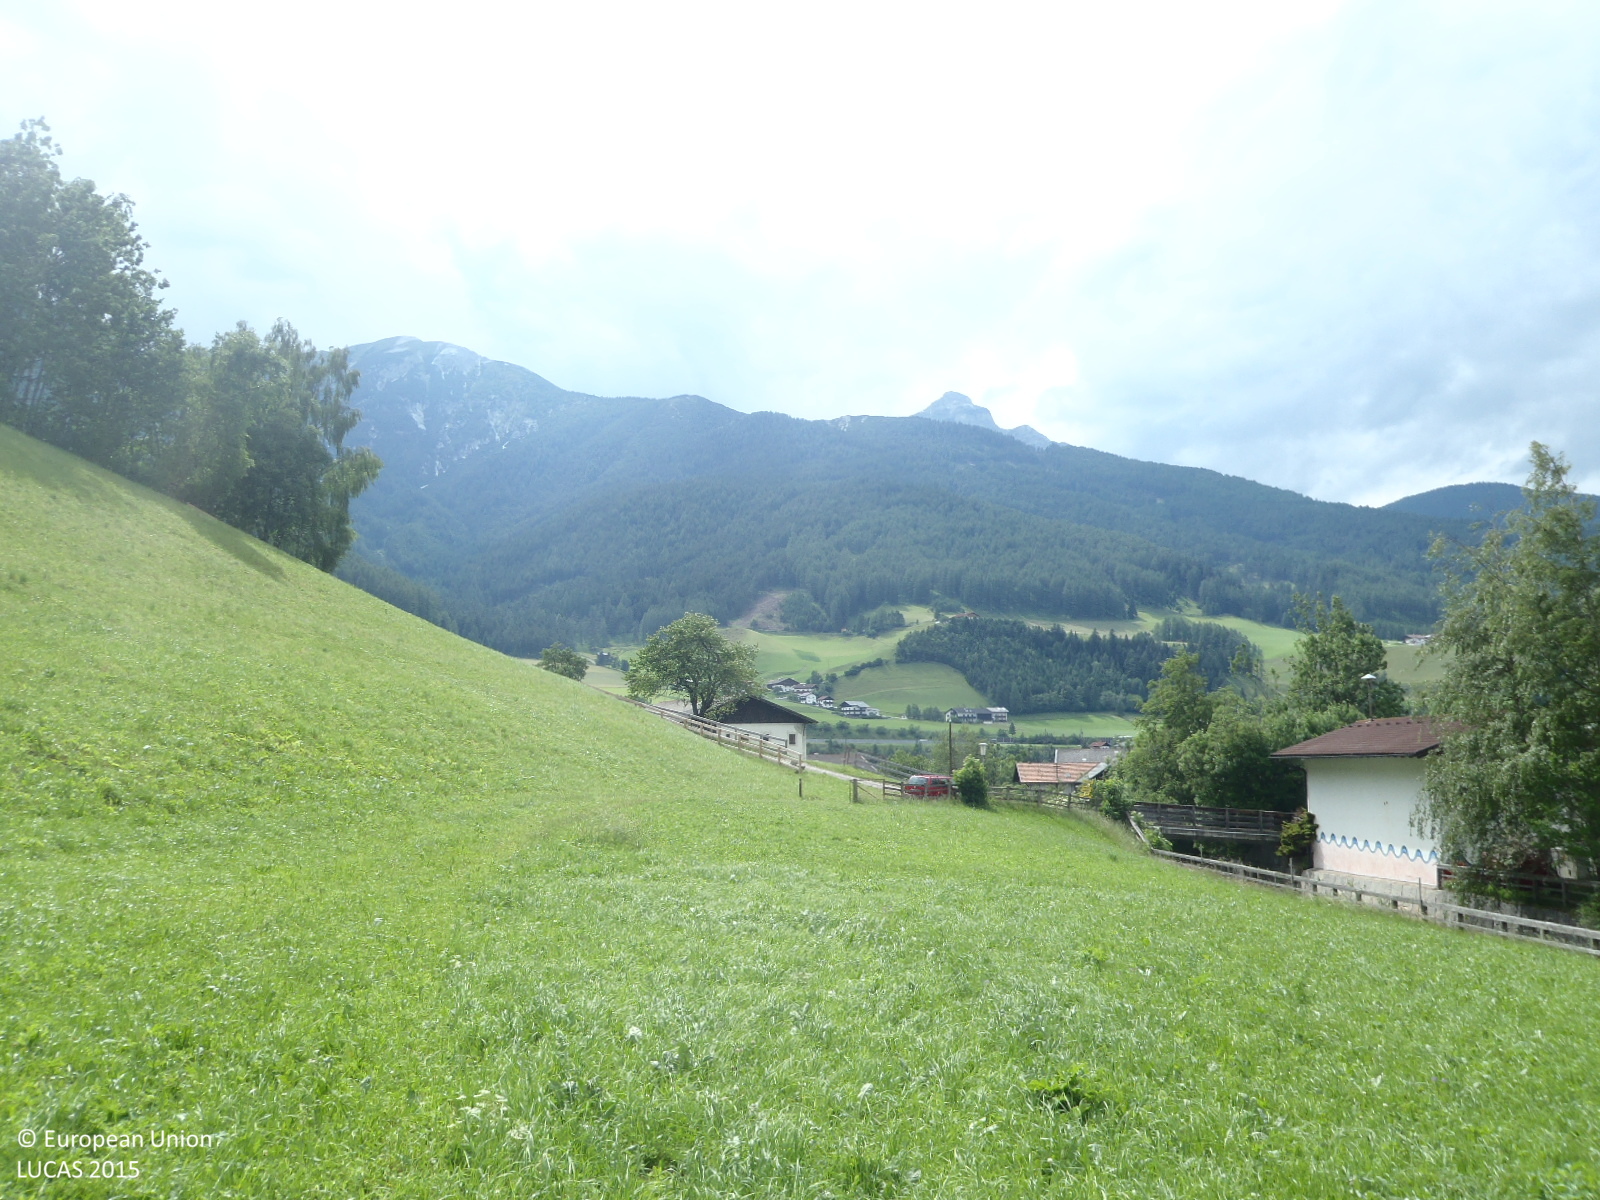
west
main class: Grassland
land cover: Grassland without tree/shrub cover
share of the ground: > 75 %
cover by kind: herbaceous plants 100 %
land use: Agriculture (excluding fallow land and kitchen gardens)
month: June
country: AT
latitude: 47.1157
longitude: 11.4615
